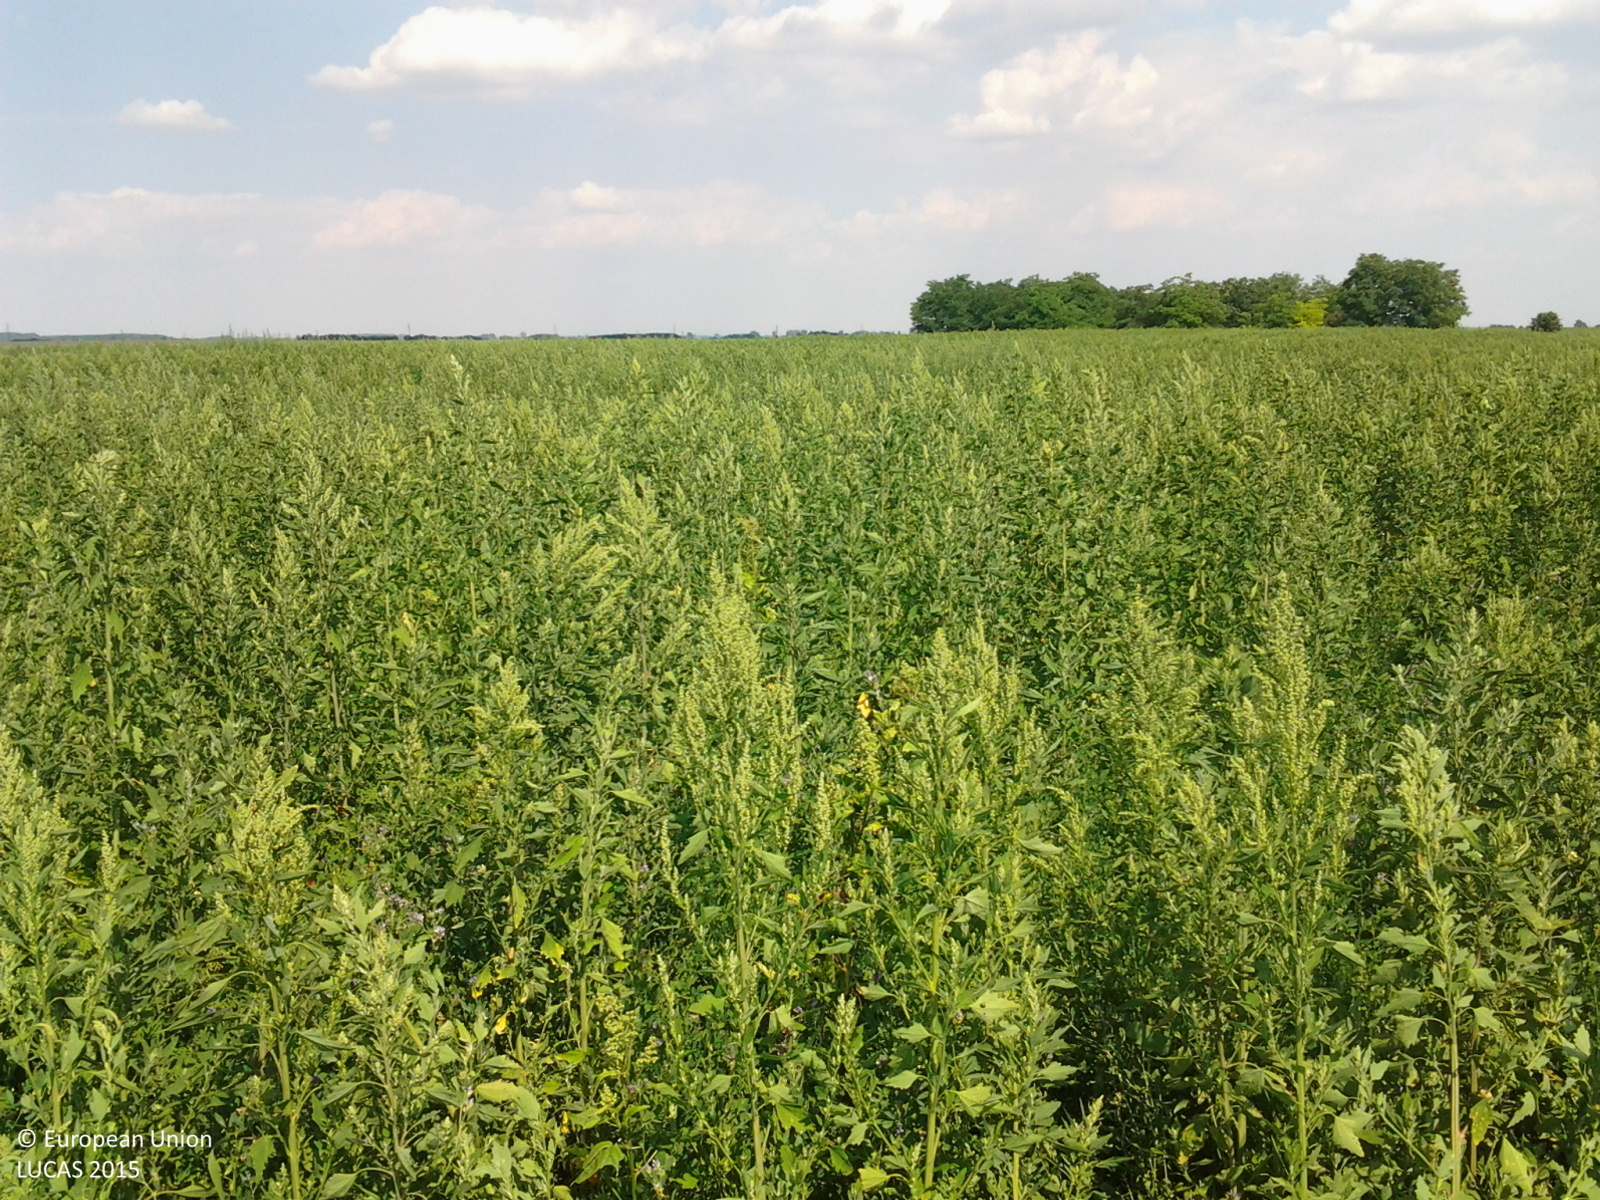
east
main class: Cropland
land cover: Lucerne
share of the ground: > 75 %
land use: Agriculture (excluding fallow land and kitchen gardens)
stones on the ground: < 10 %
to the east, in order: Lucerne; Broadleaved woodland; Lucerne
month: July
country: HU
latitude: 47.5487
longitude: 19.8173
